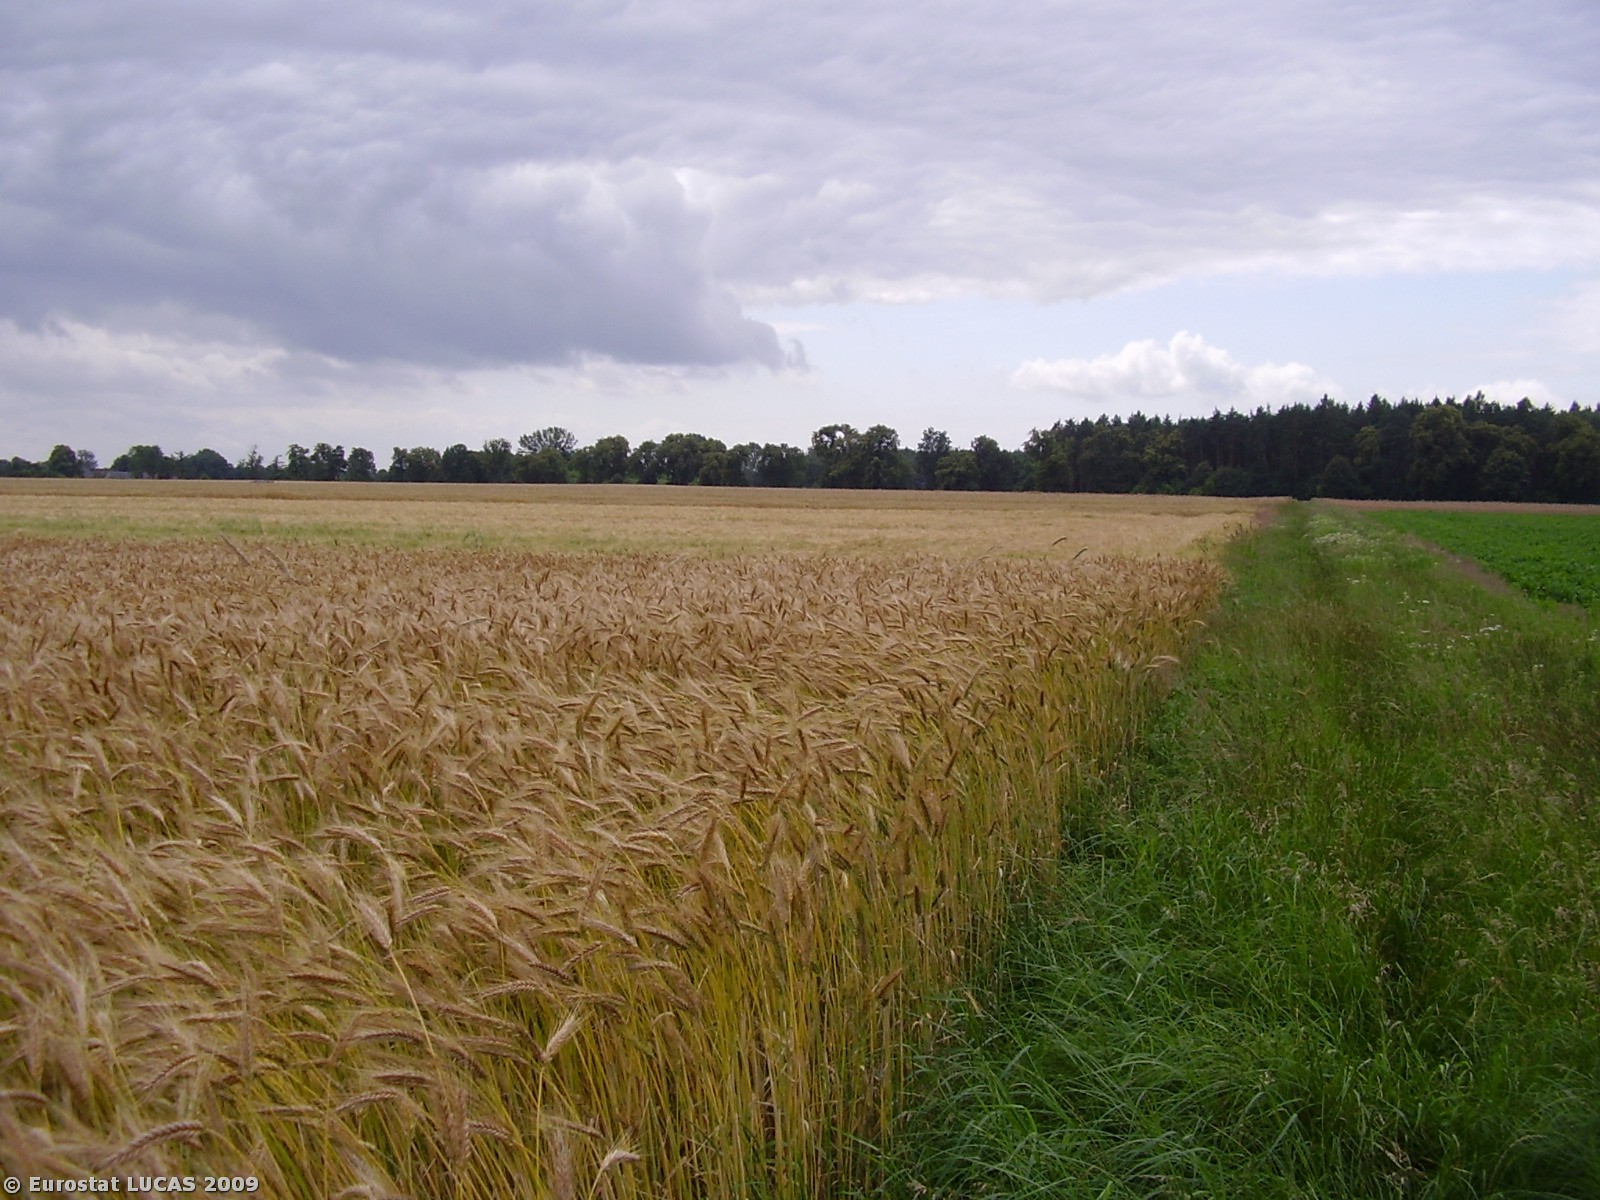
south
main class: Cropland
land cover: Triticale
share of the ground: > 75 %
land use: Agriculture (excluding fallow land and kitchen gardens)
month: July
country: PL
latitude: 51.2259
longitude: 17.6748
